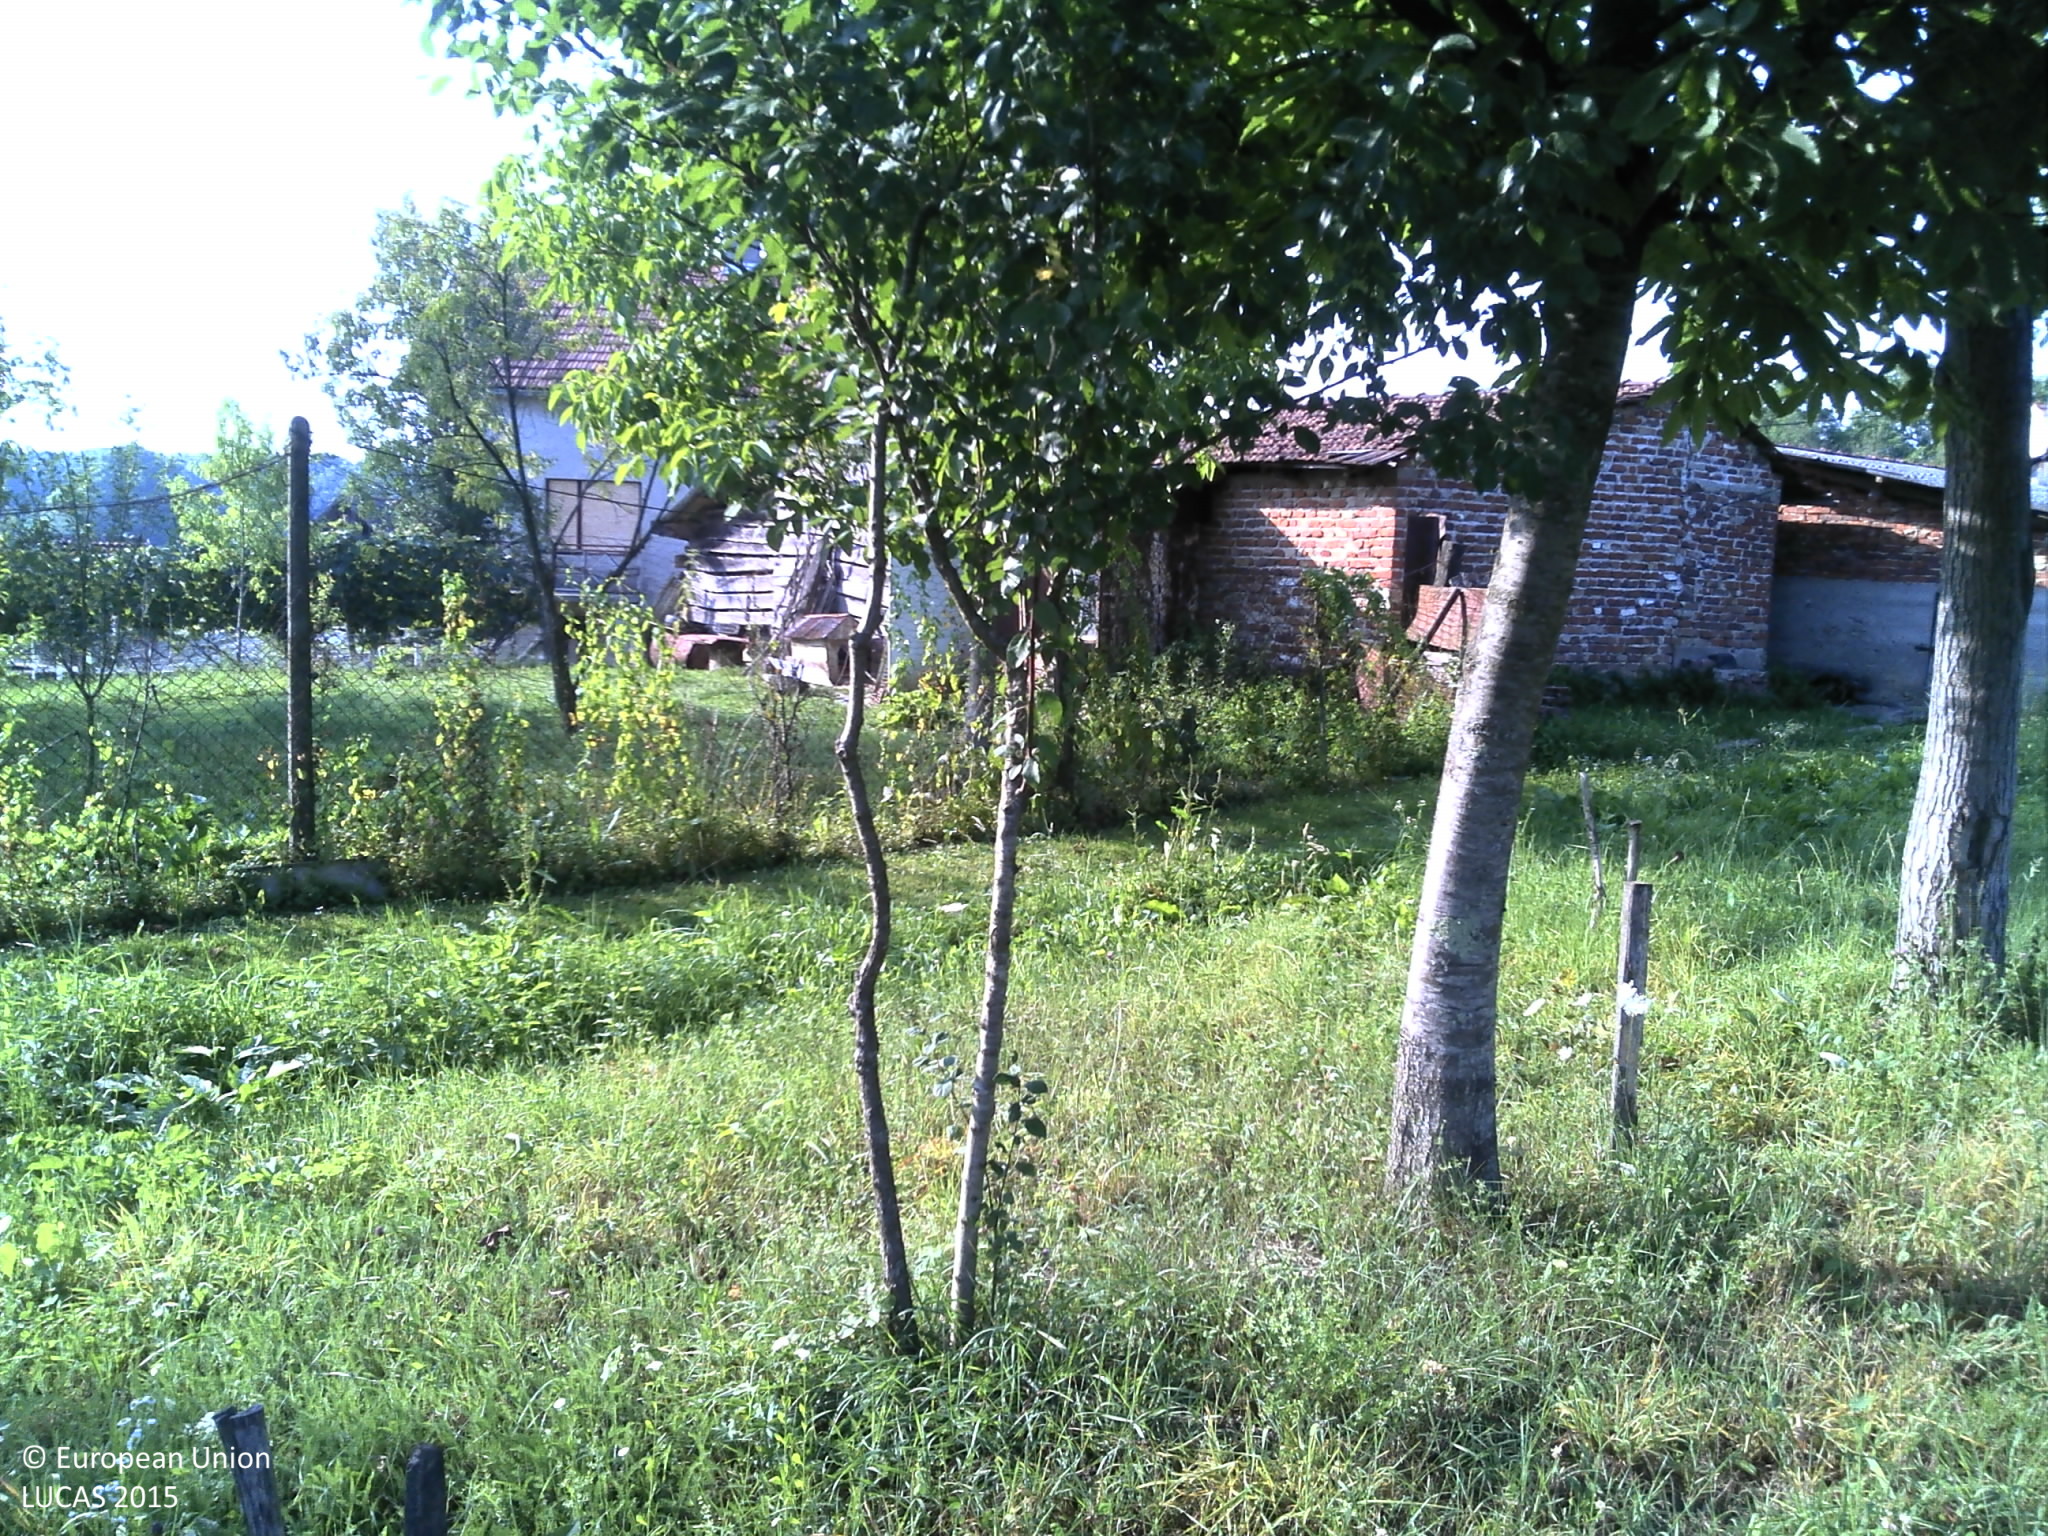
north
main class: Cropland
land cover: Other fresh vegetables
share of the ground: 50 - 75 %
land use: Kitchen garden
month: July
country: HR
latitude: 45.8301
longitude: 16.7583
